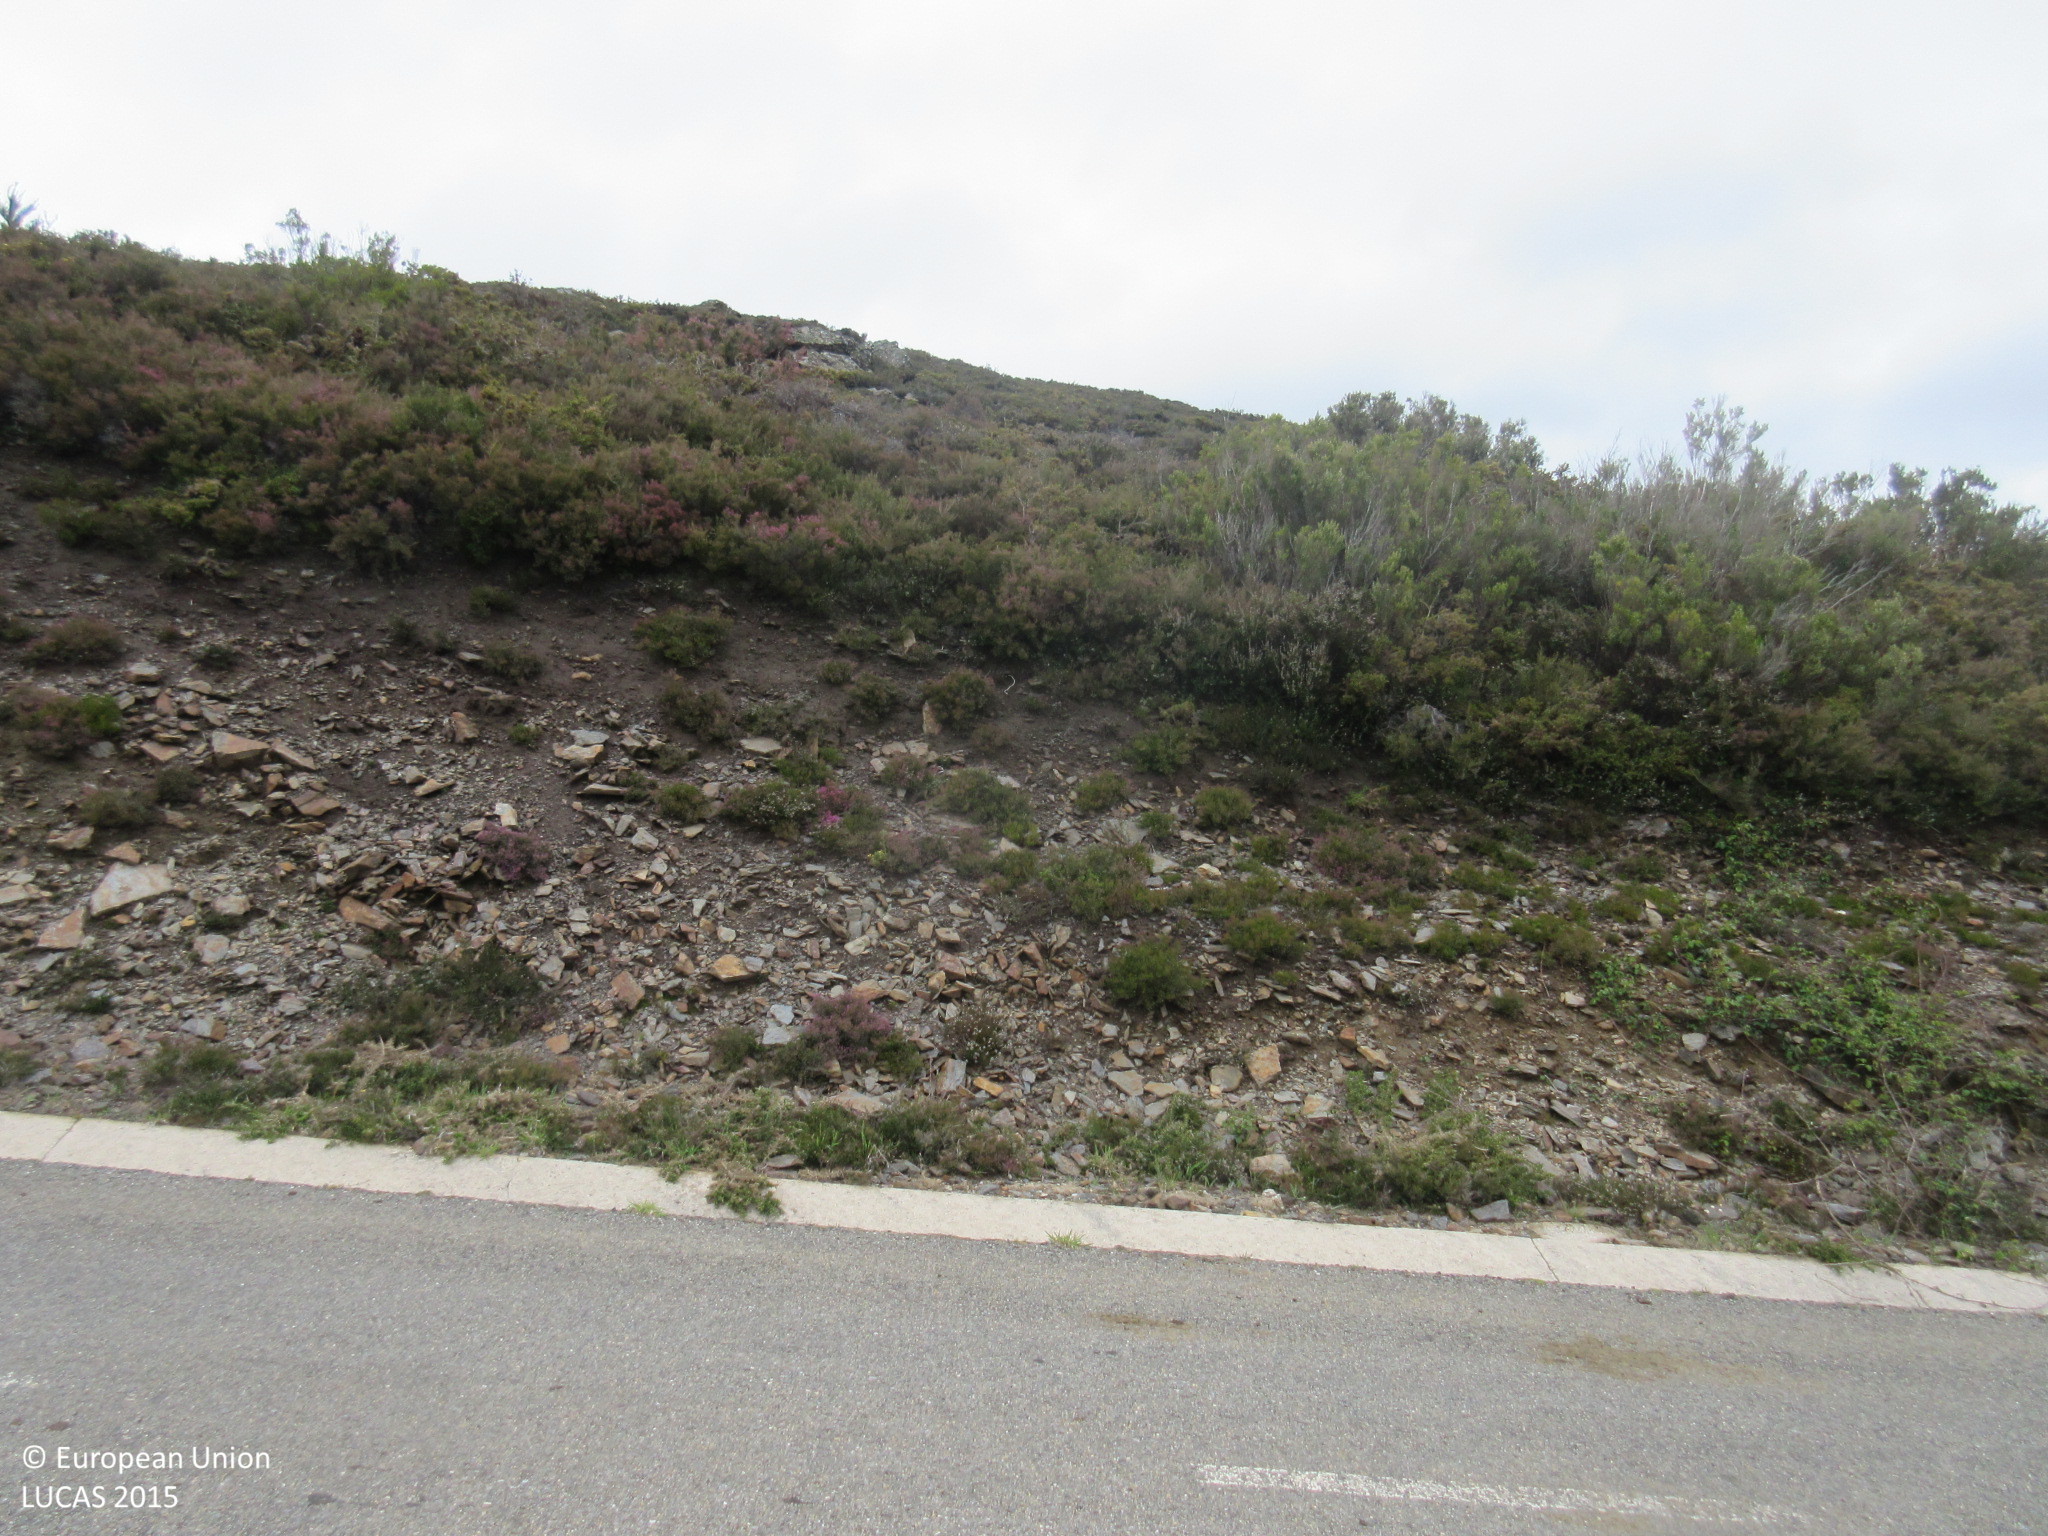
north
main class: Shrubland
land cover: Shrubland without tree cover
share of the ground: > 75 %
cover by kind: shrubs 100 %
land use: Semi-natural and natural areas not in use
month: April
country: ES
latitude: 43.3344
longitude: -6.9244
